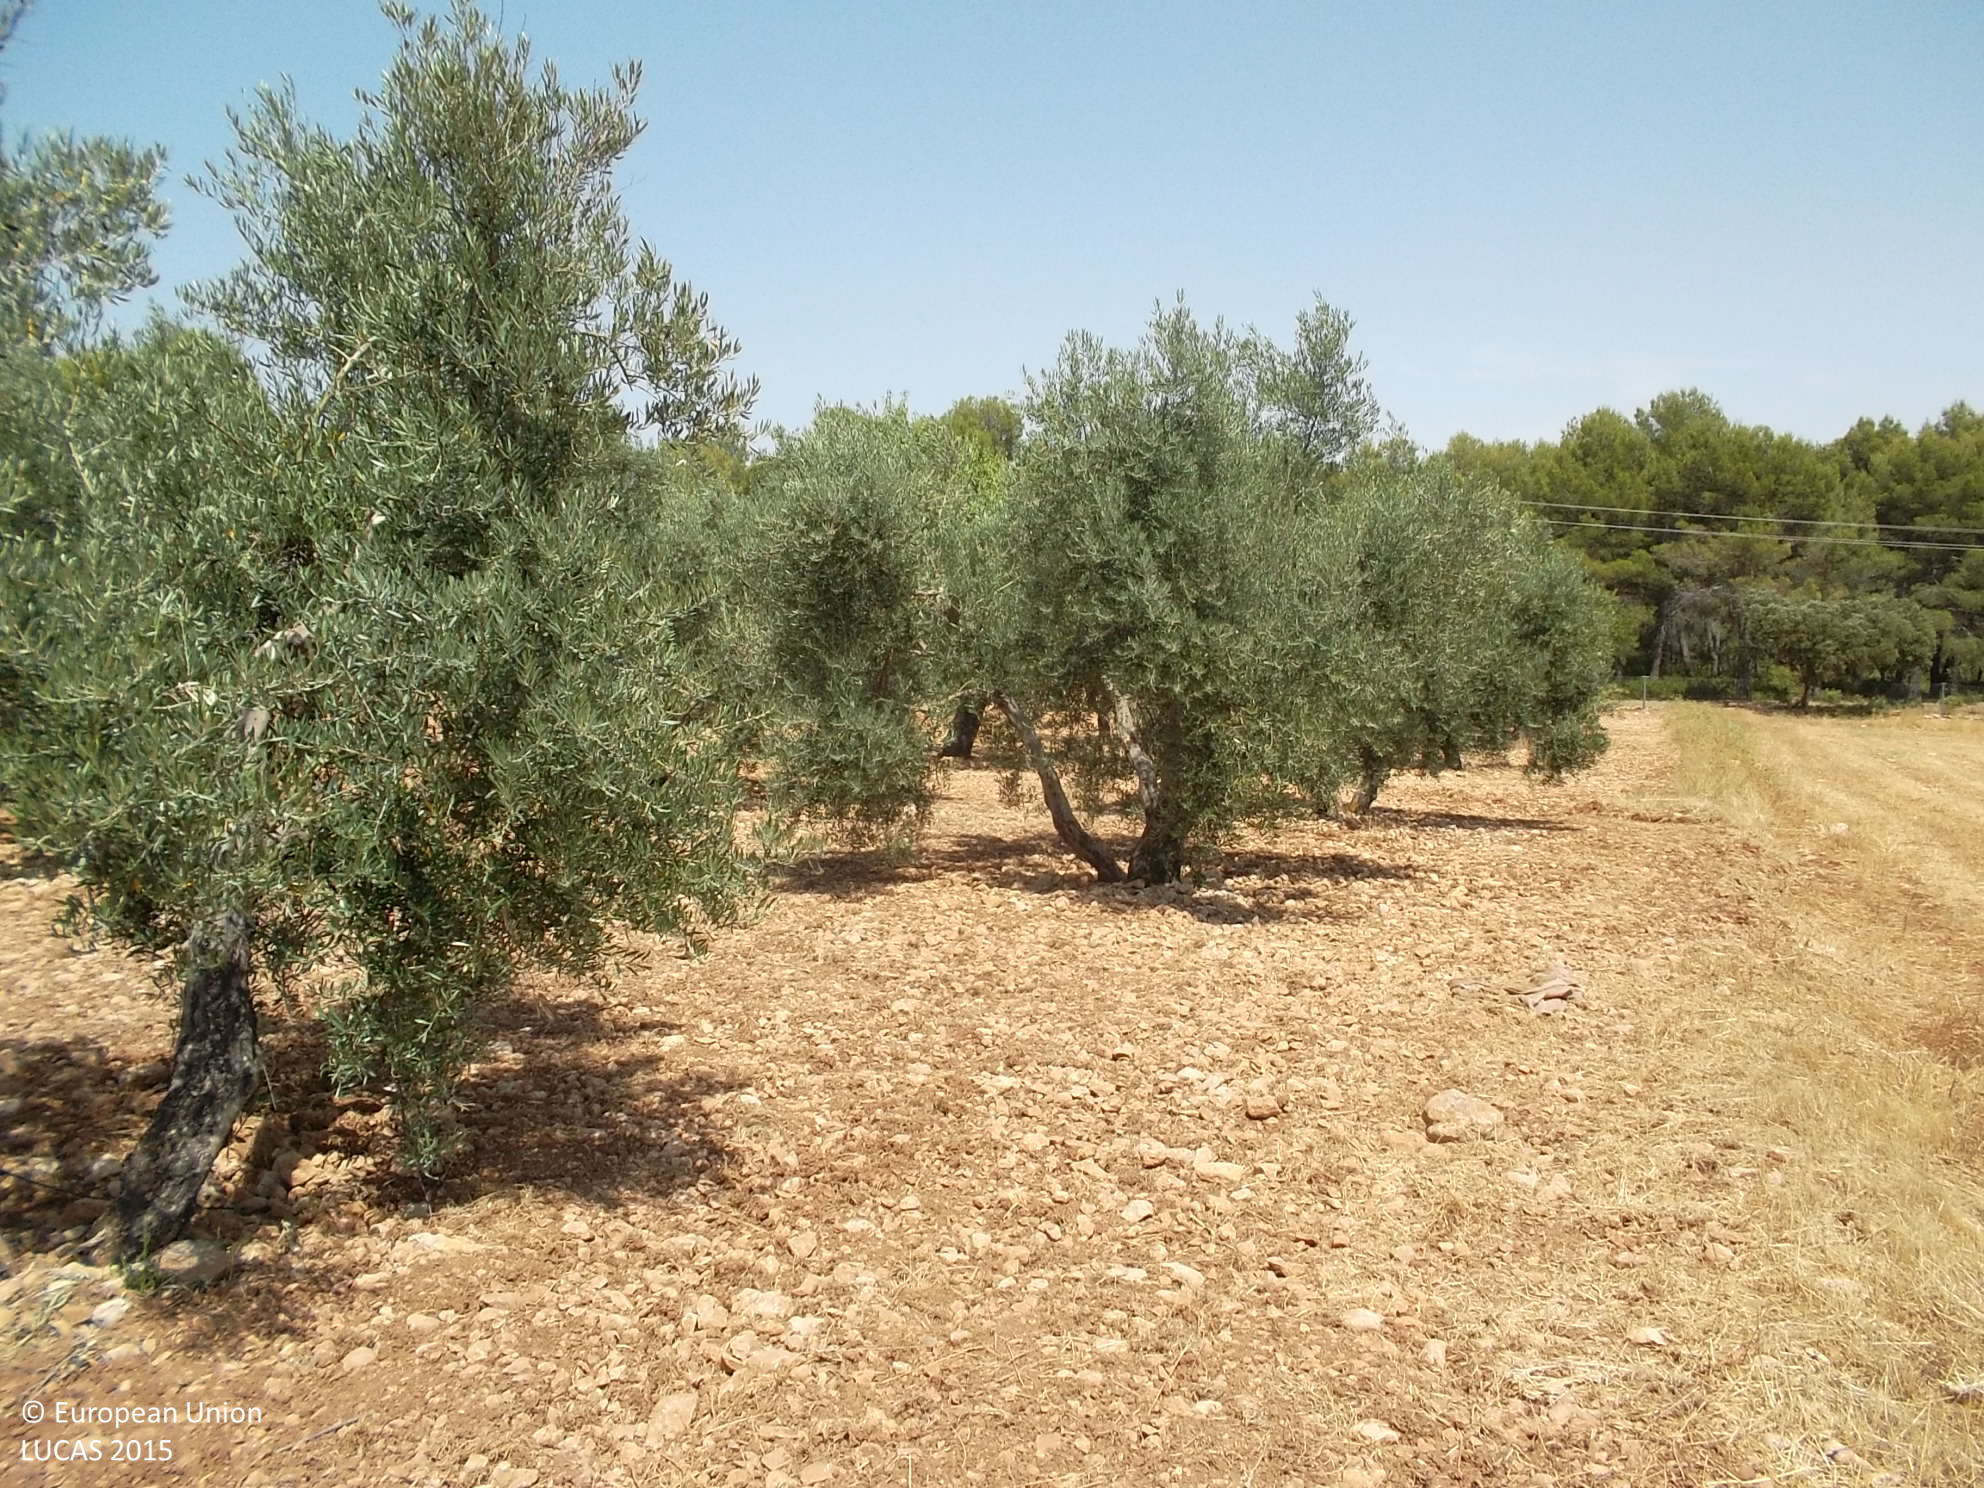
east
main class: Cropland
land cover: Olive groves
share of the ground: 25 - 50 %
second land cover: Other bare soil
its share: > 75 %
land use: Agriculture (excluding fallow land and kitchen gardens)
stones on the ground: 10 - 25 %
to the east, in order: Olive groves; Other bare soil; Nuts trees; Electric lines; Nuts trees; Grass margins; Tracks; Grass margins; Fences; Pine dominated coniferous woodland; Shrubland without tree cover
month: June
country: ES
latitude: 37.7606
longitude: -2.9211
